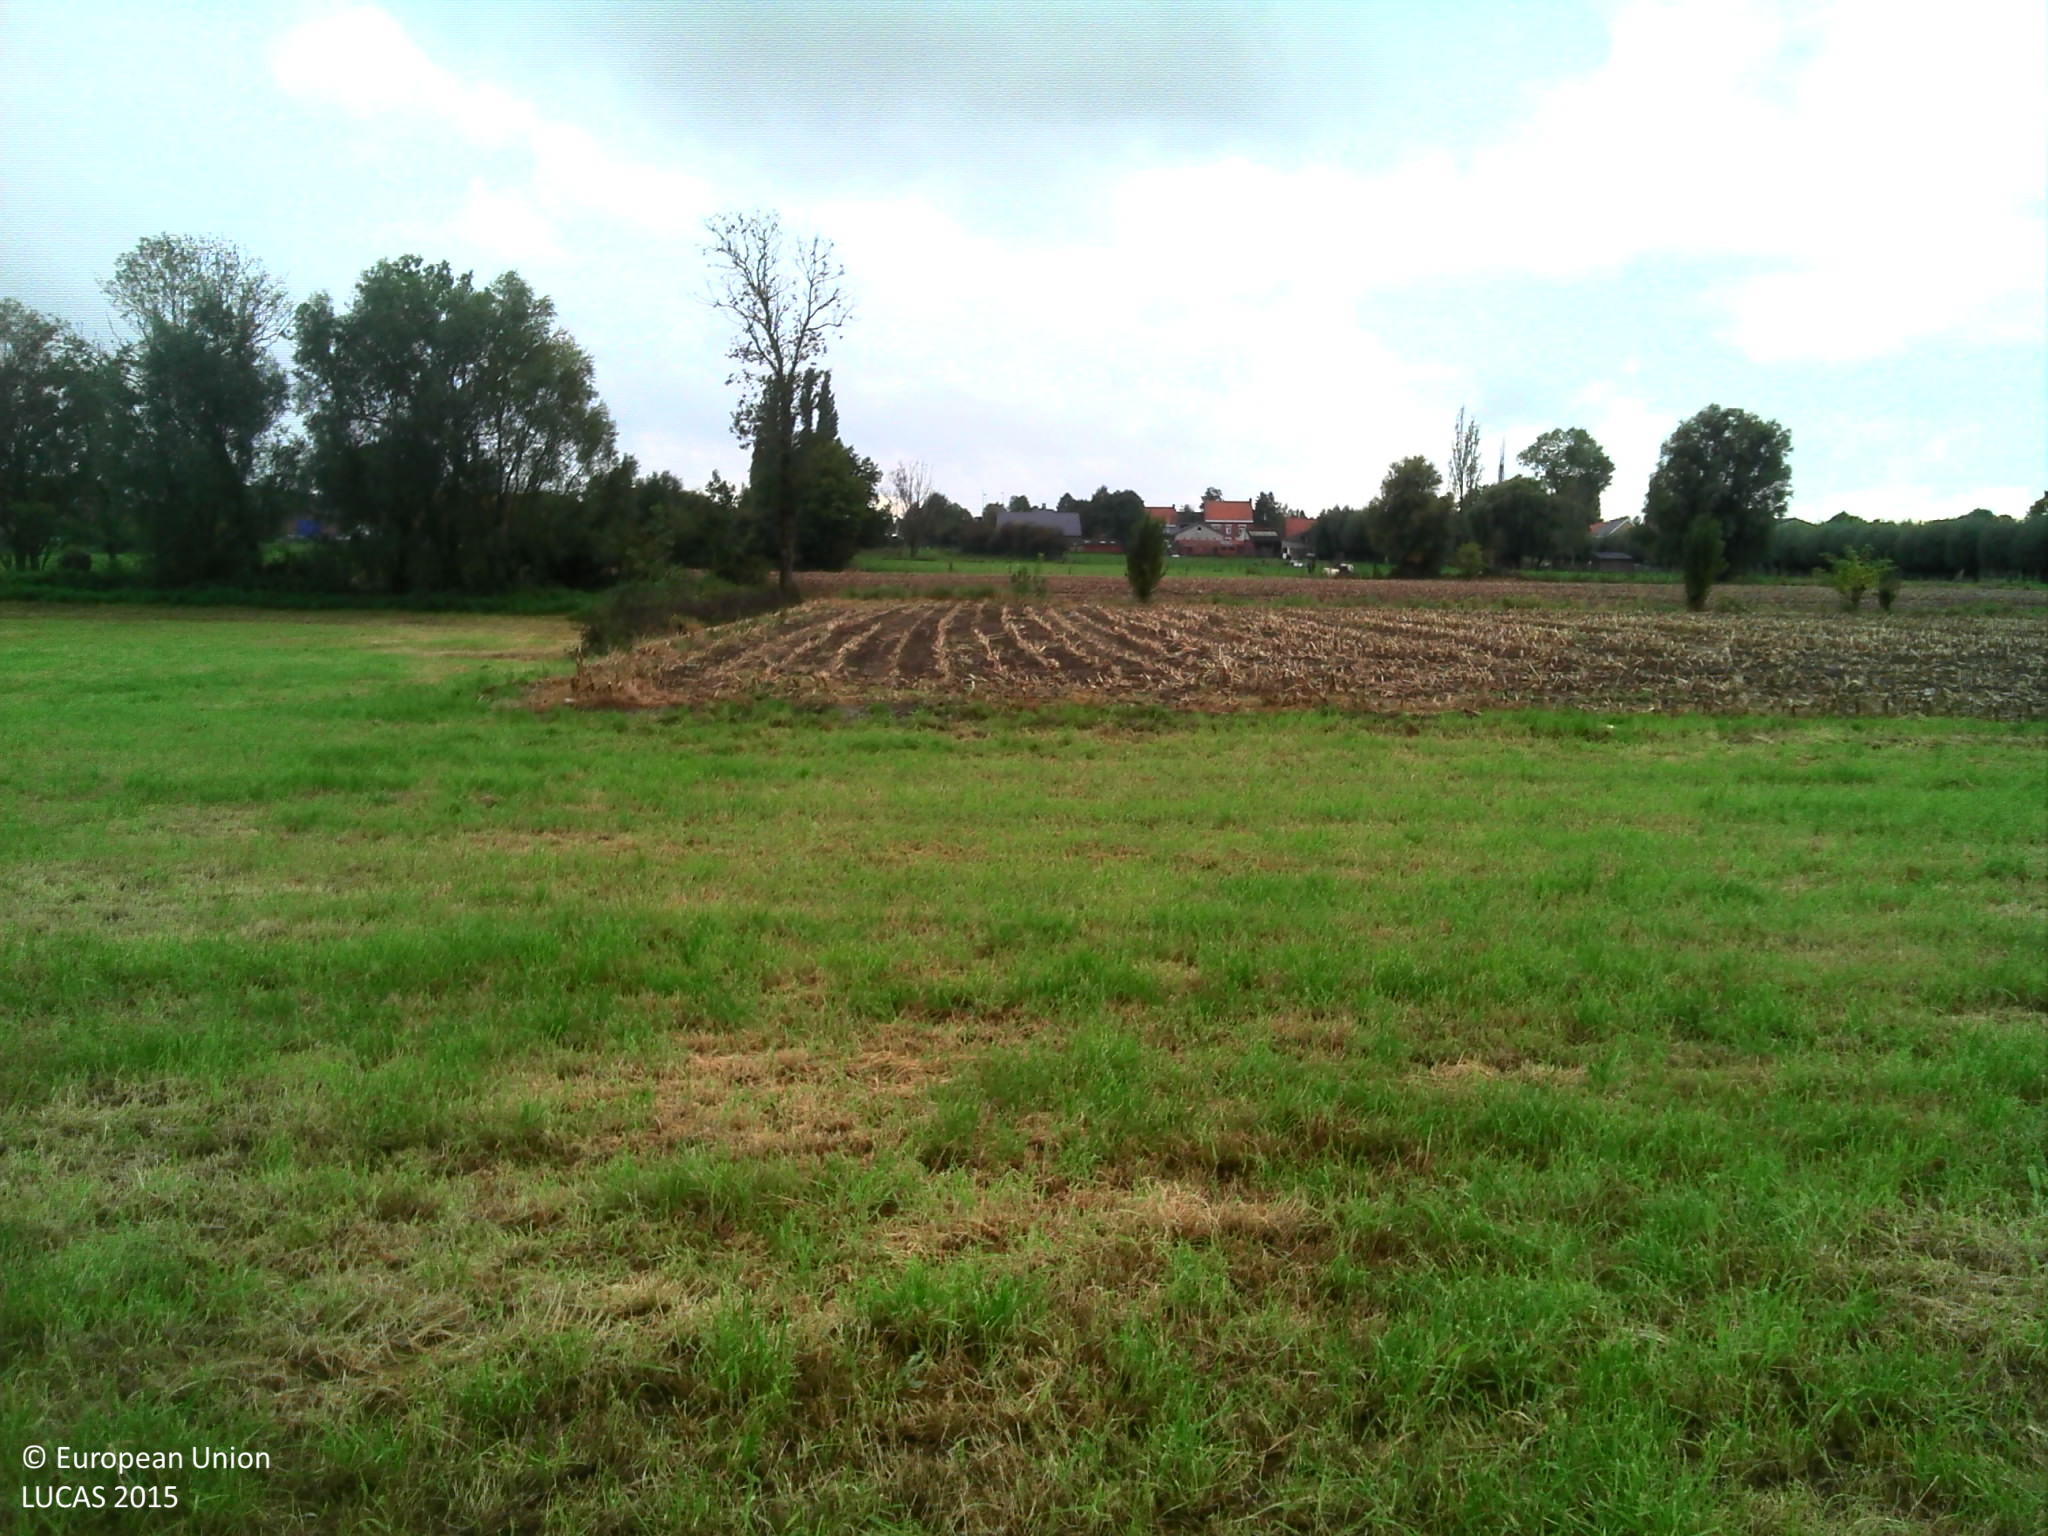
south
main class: Cropland
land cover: Temporary grasslands
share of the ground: > 75 %
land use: Agriculture (excluding fallow land and kitchen gardens)
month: October
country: BE
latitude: 50.9651
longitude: 3.0558
